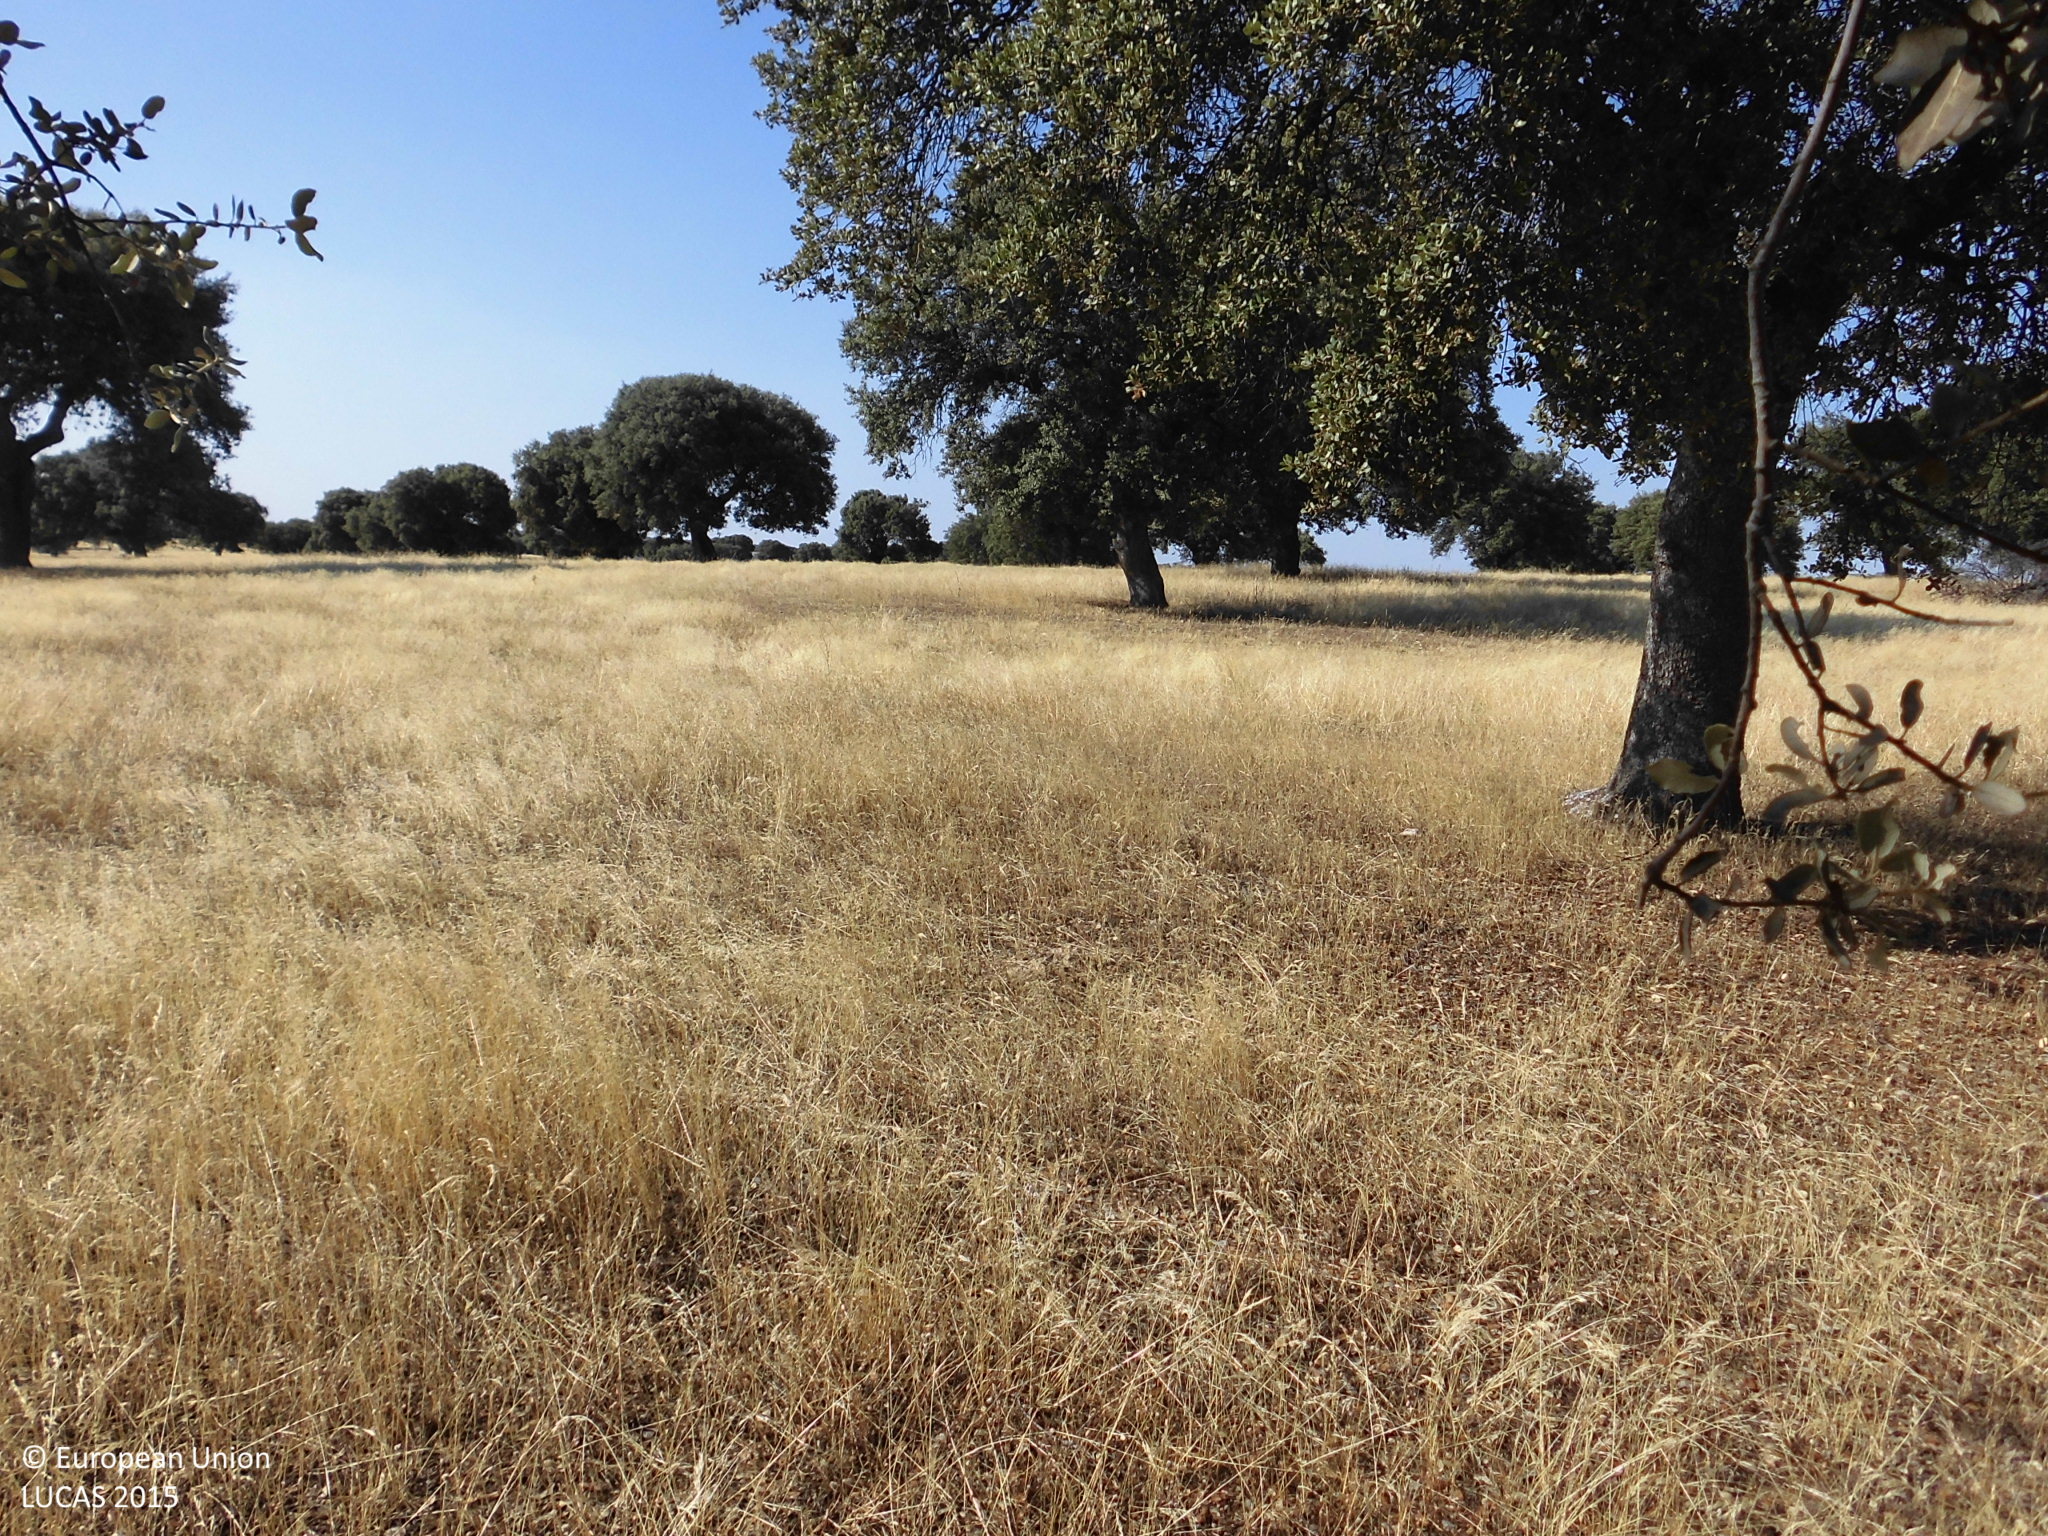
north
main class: Woodland
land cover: Broadleaved woodland
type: broadleaved evergreen forest
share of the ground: 10 - 25 %
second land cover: Grassland without tree/shrub cover
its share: > 75 %
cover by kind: herbaceous plants 85 %, broadleaved forest trees 15 %
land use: Forestry
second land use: Agriculture (excluding fallow land and kitchen gardens)
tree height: > 5 m
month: June
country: ES
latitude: 39.6451
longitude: -5.9932
